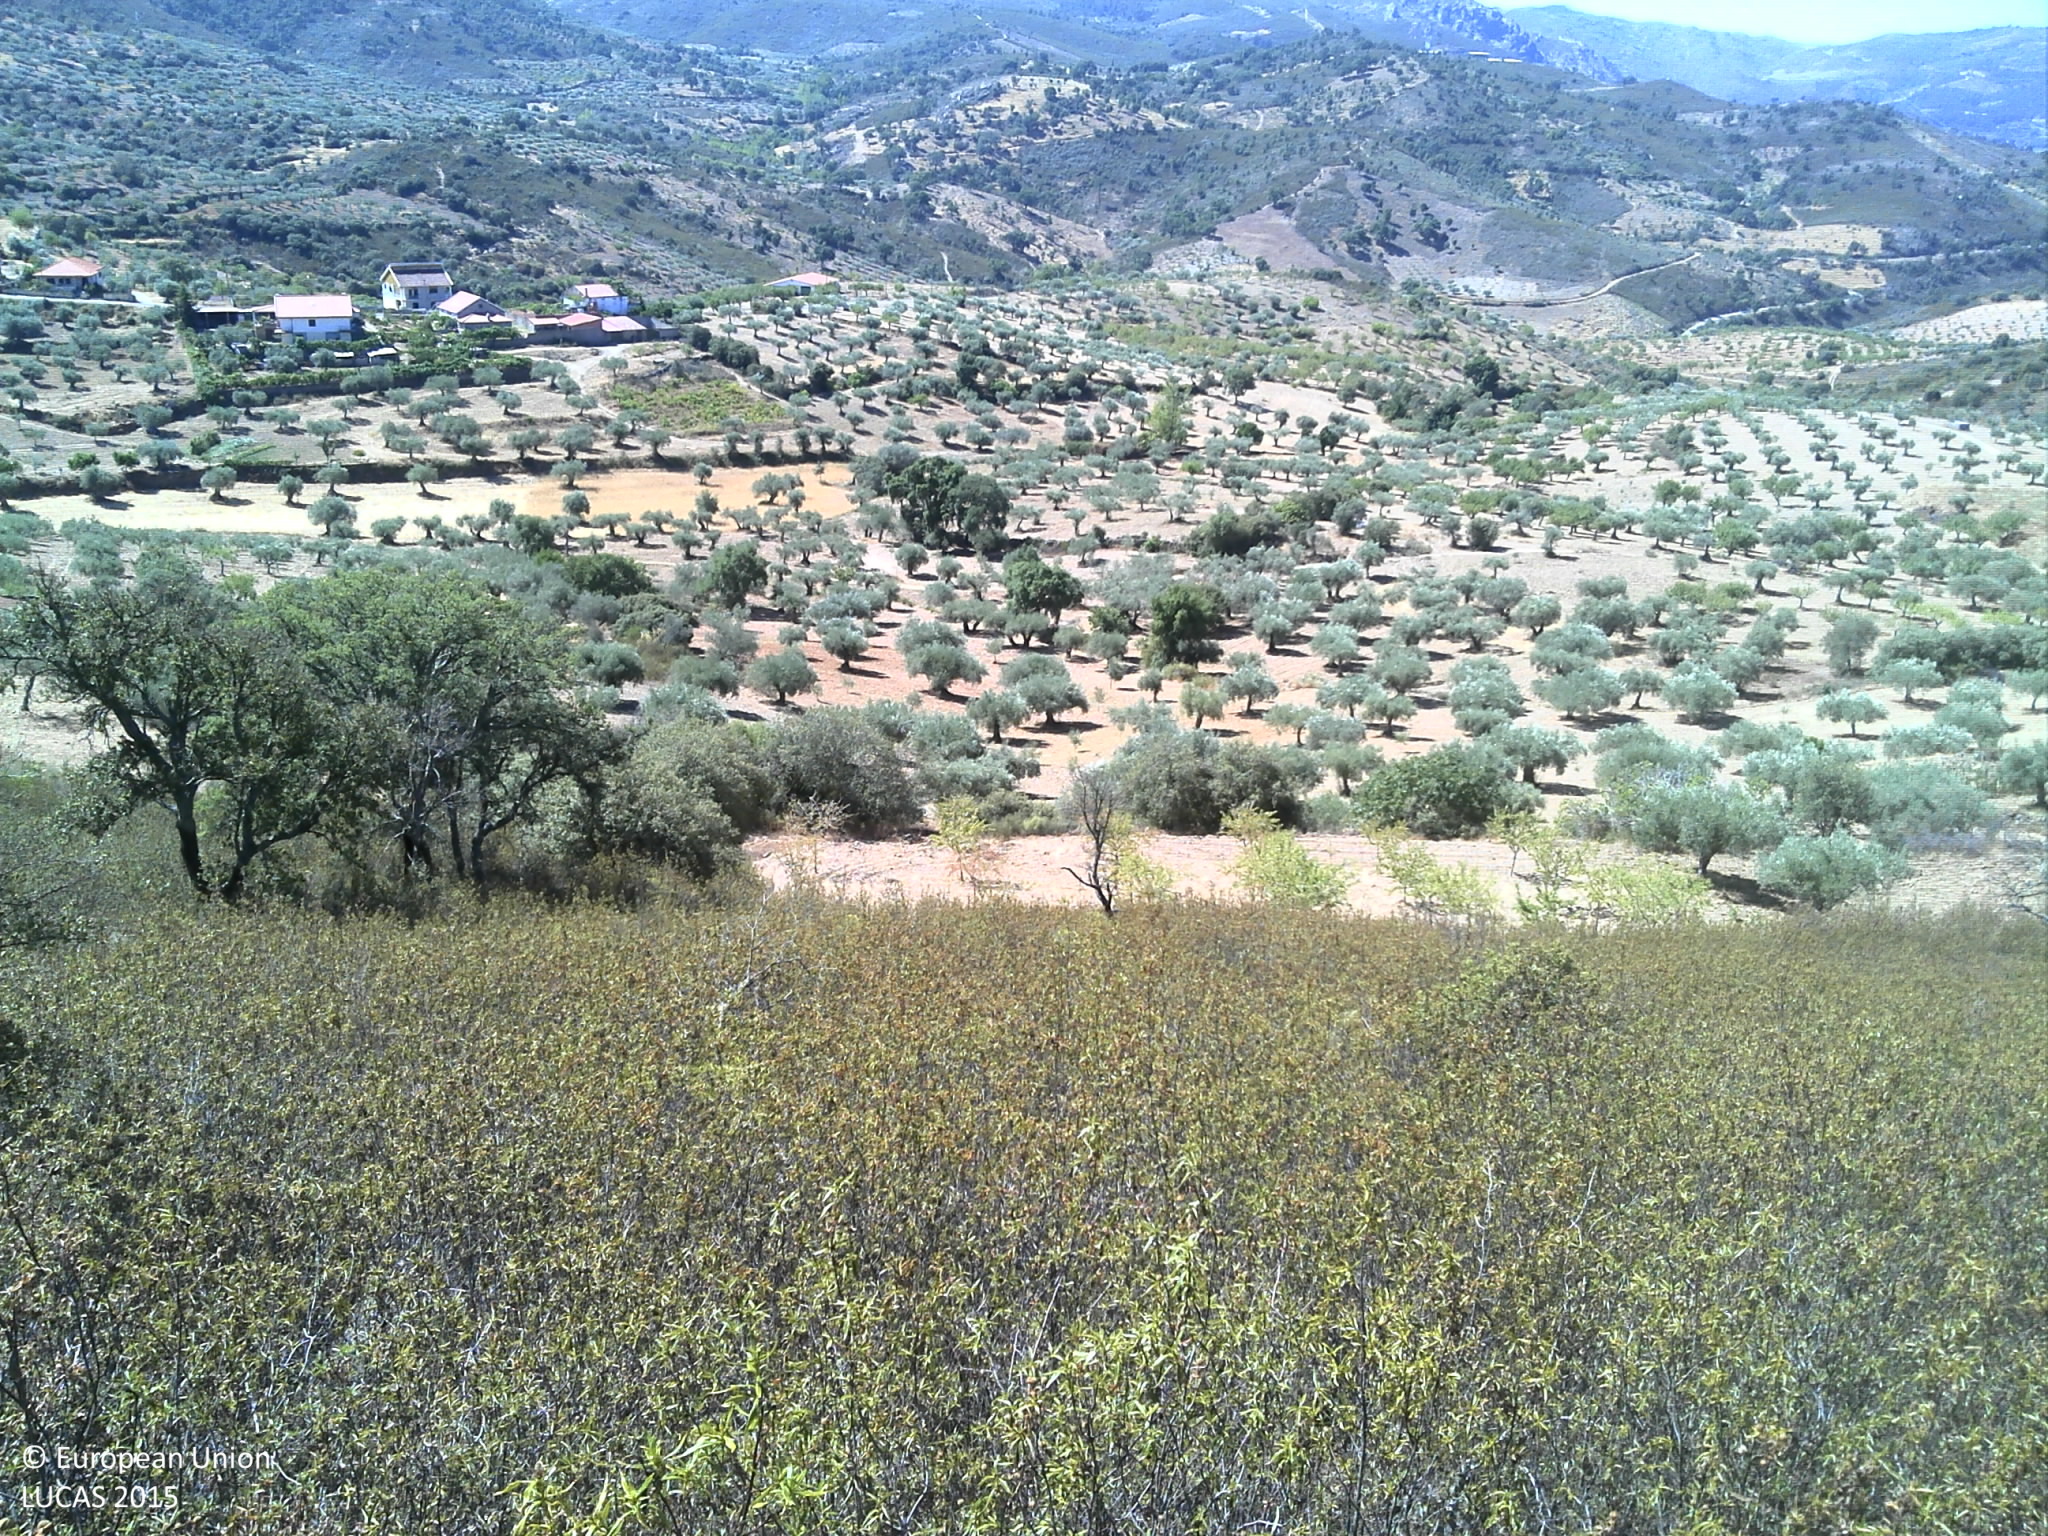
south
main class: Shrubland
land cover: Shrubland with sparse tree cover
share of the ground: > 75 %
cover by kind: shrubs 95 %, broadleaved forest trees 5 %
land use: Semi-natural and natural areas not in use
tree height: > 5 m
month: July
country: PT
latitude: 41.4016
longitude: -7.1375
